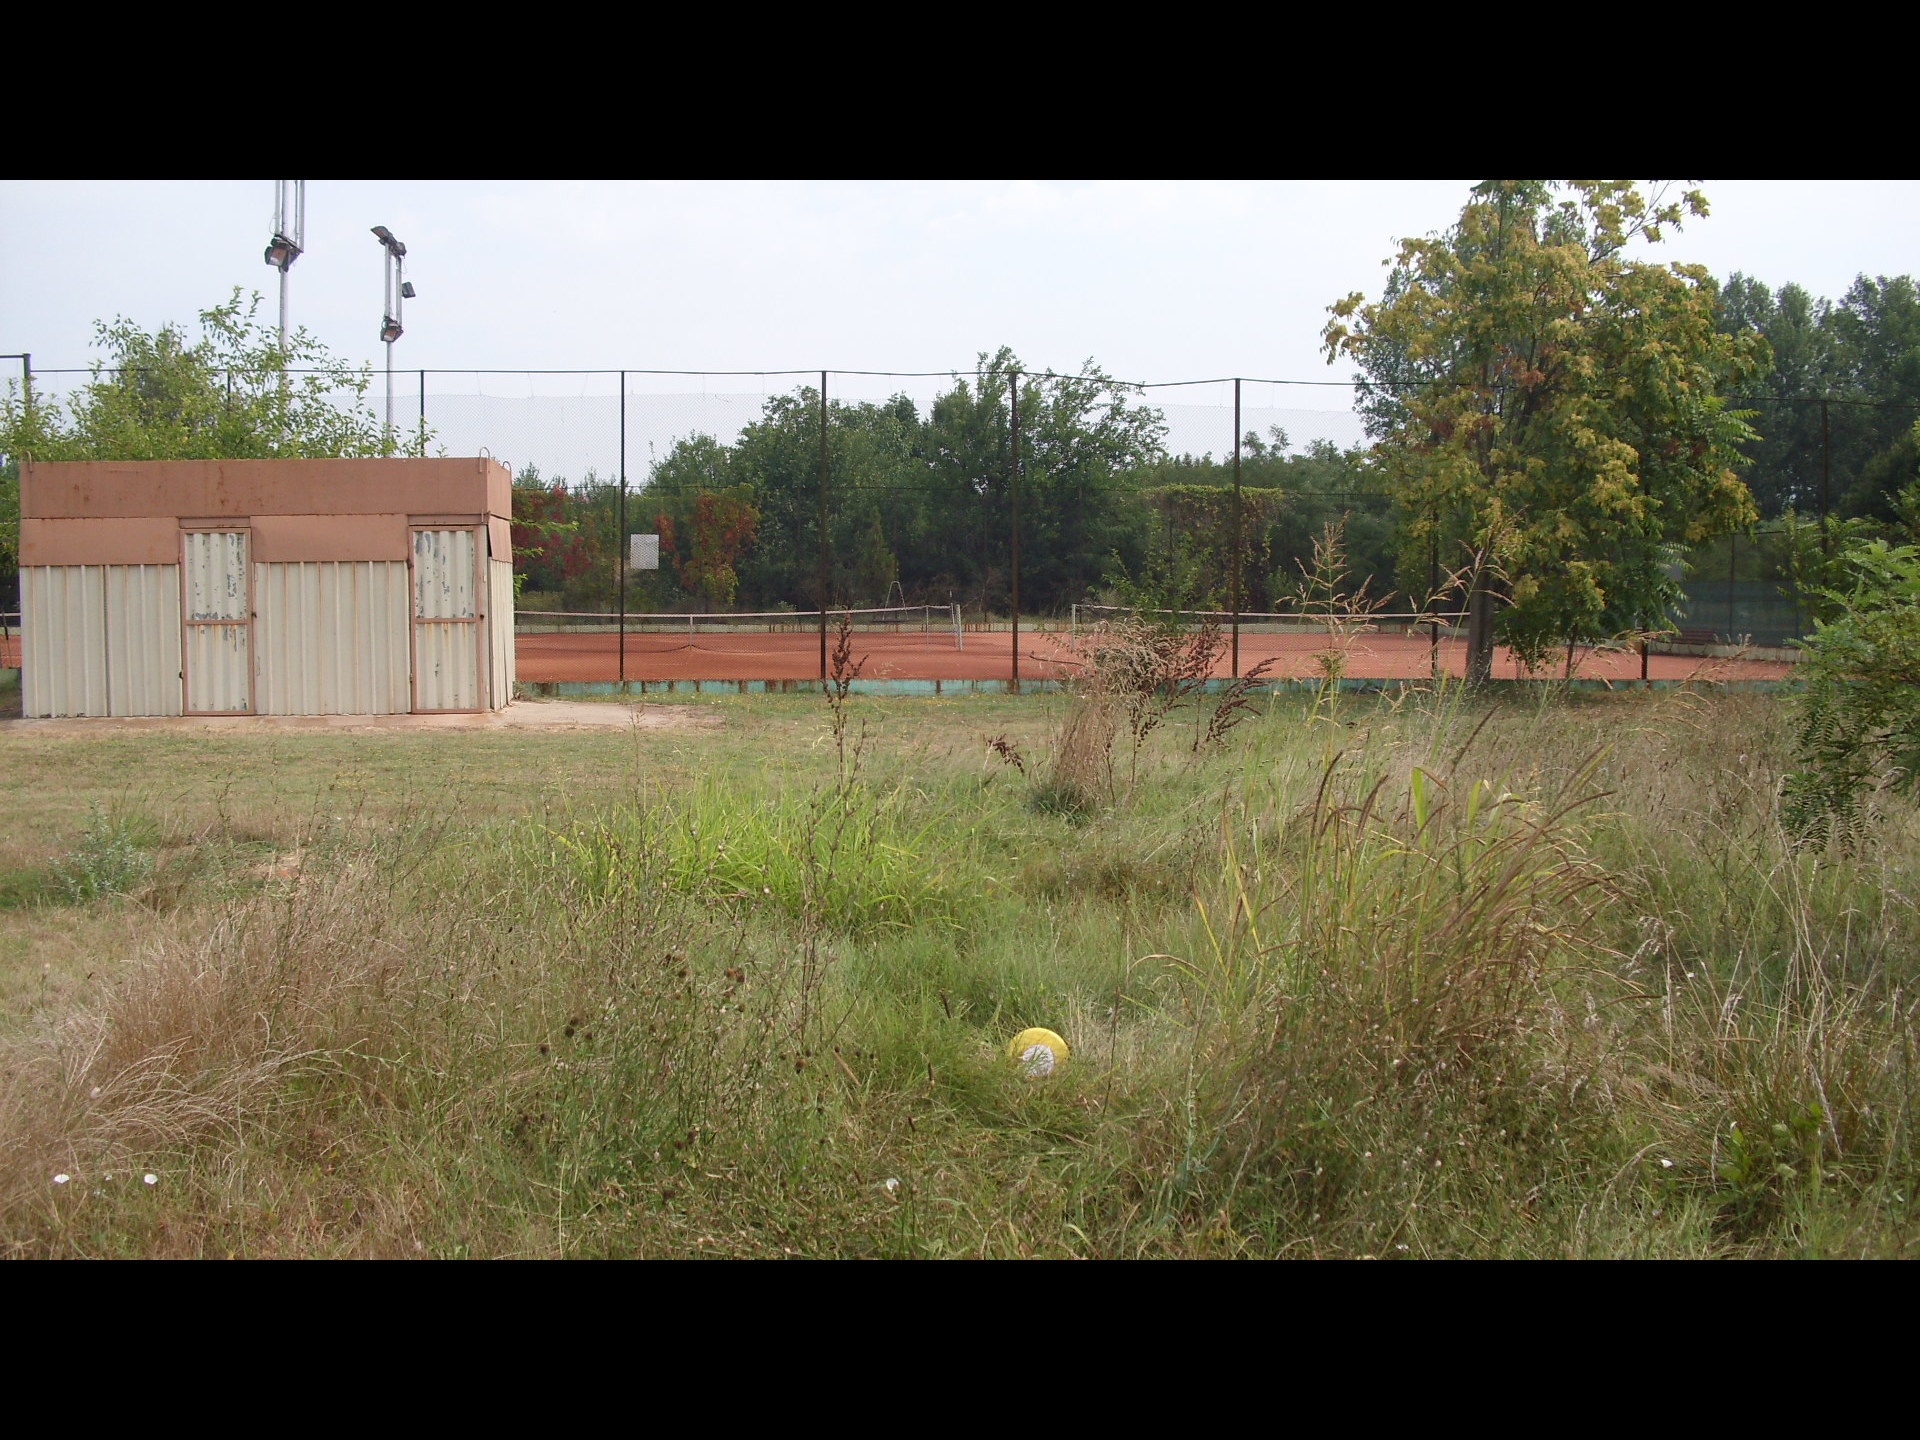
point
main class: Grassland
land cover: Grassland with sparse tree/shrub cover
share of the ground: > 75 %
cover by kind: herbaceous plants 85 %, shrubs 10 %, broadleaved forest trees 5 %
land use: Abandoned areas
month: July
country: BG
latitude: 43.7800
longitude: 23.7309
